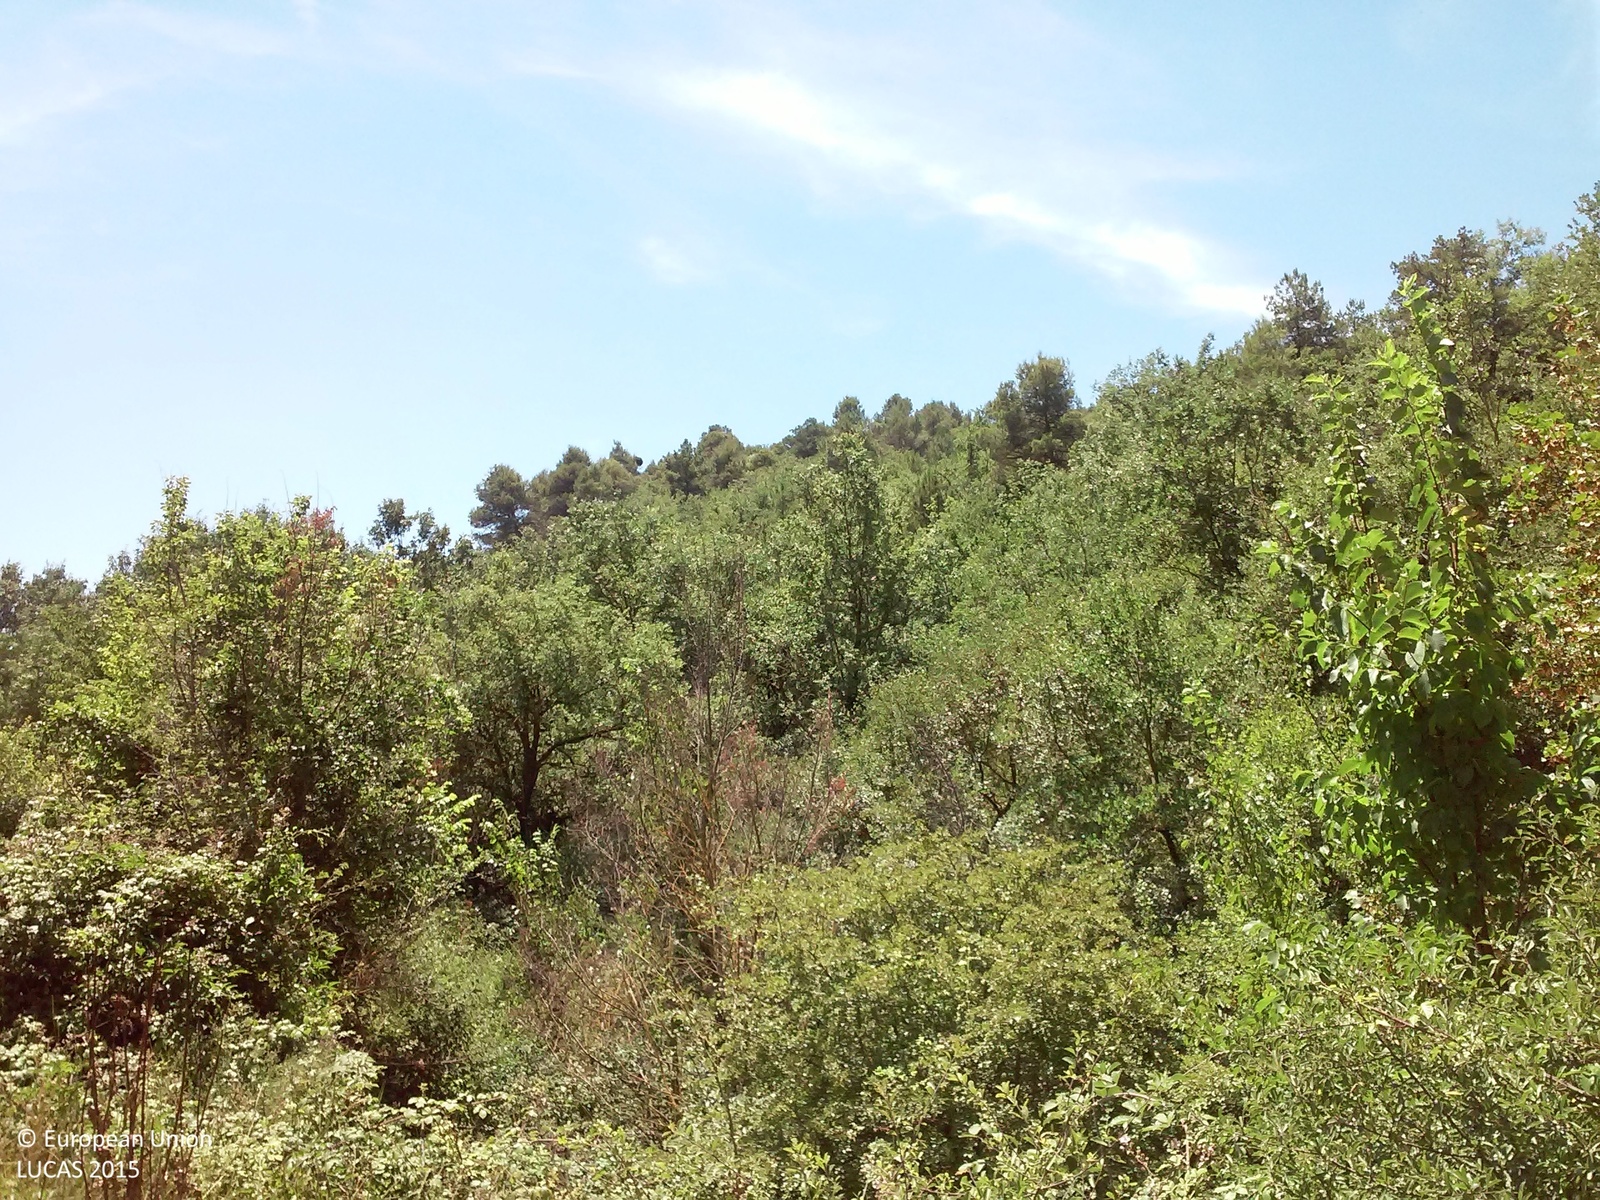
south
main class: Woodland
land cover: Broadleaved woodland
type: broadleaved evergreen forest
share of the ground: 50 - 75 %
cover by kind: herbaceous plants 40 %, broadleaved forest trees 25 %, shrubs 25 %, lichens and mosses 10 %
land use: Semi-natural and natural areas not in use
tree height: < 5 m
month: July
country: ES
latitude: 41.5284
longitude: 1.2300
